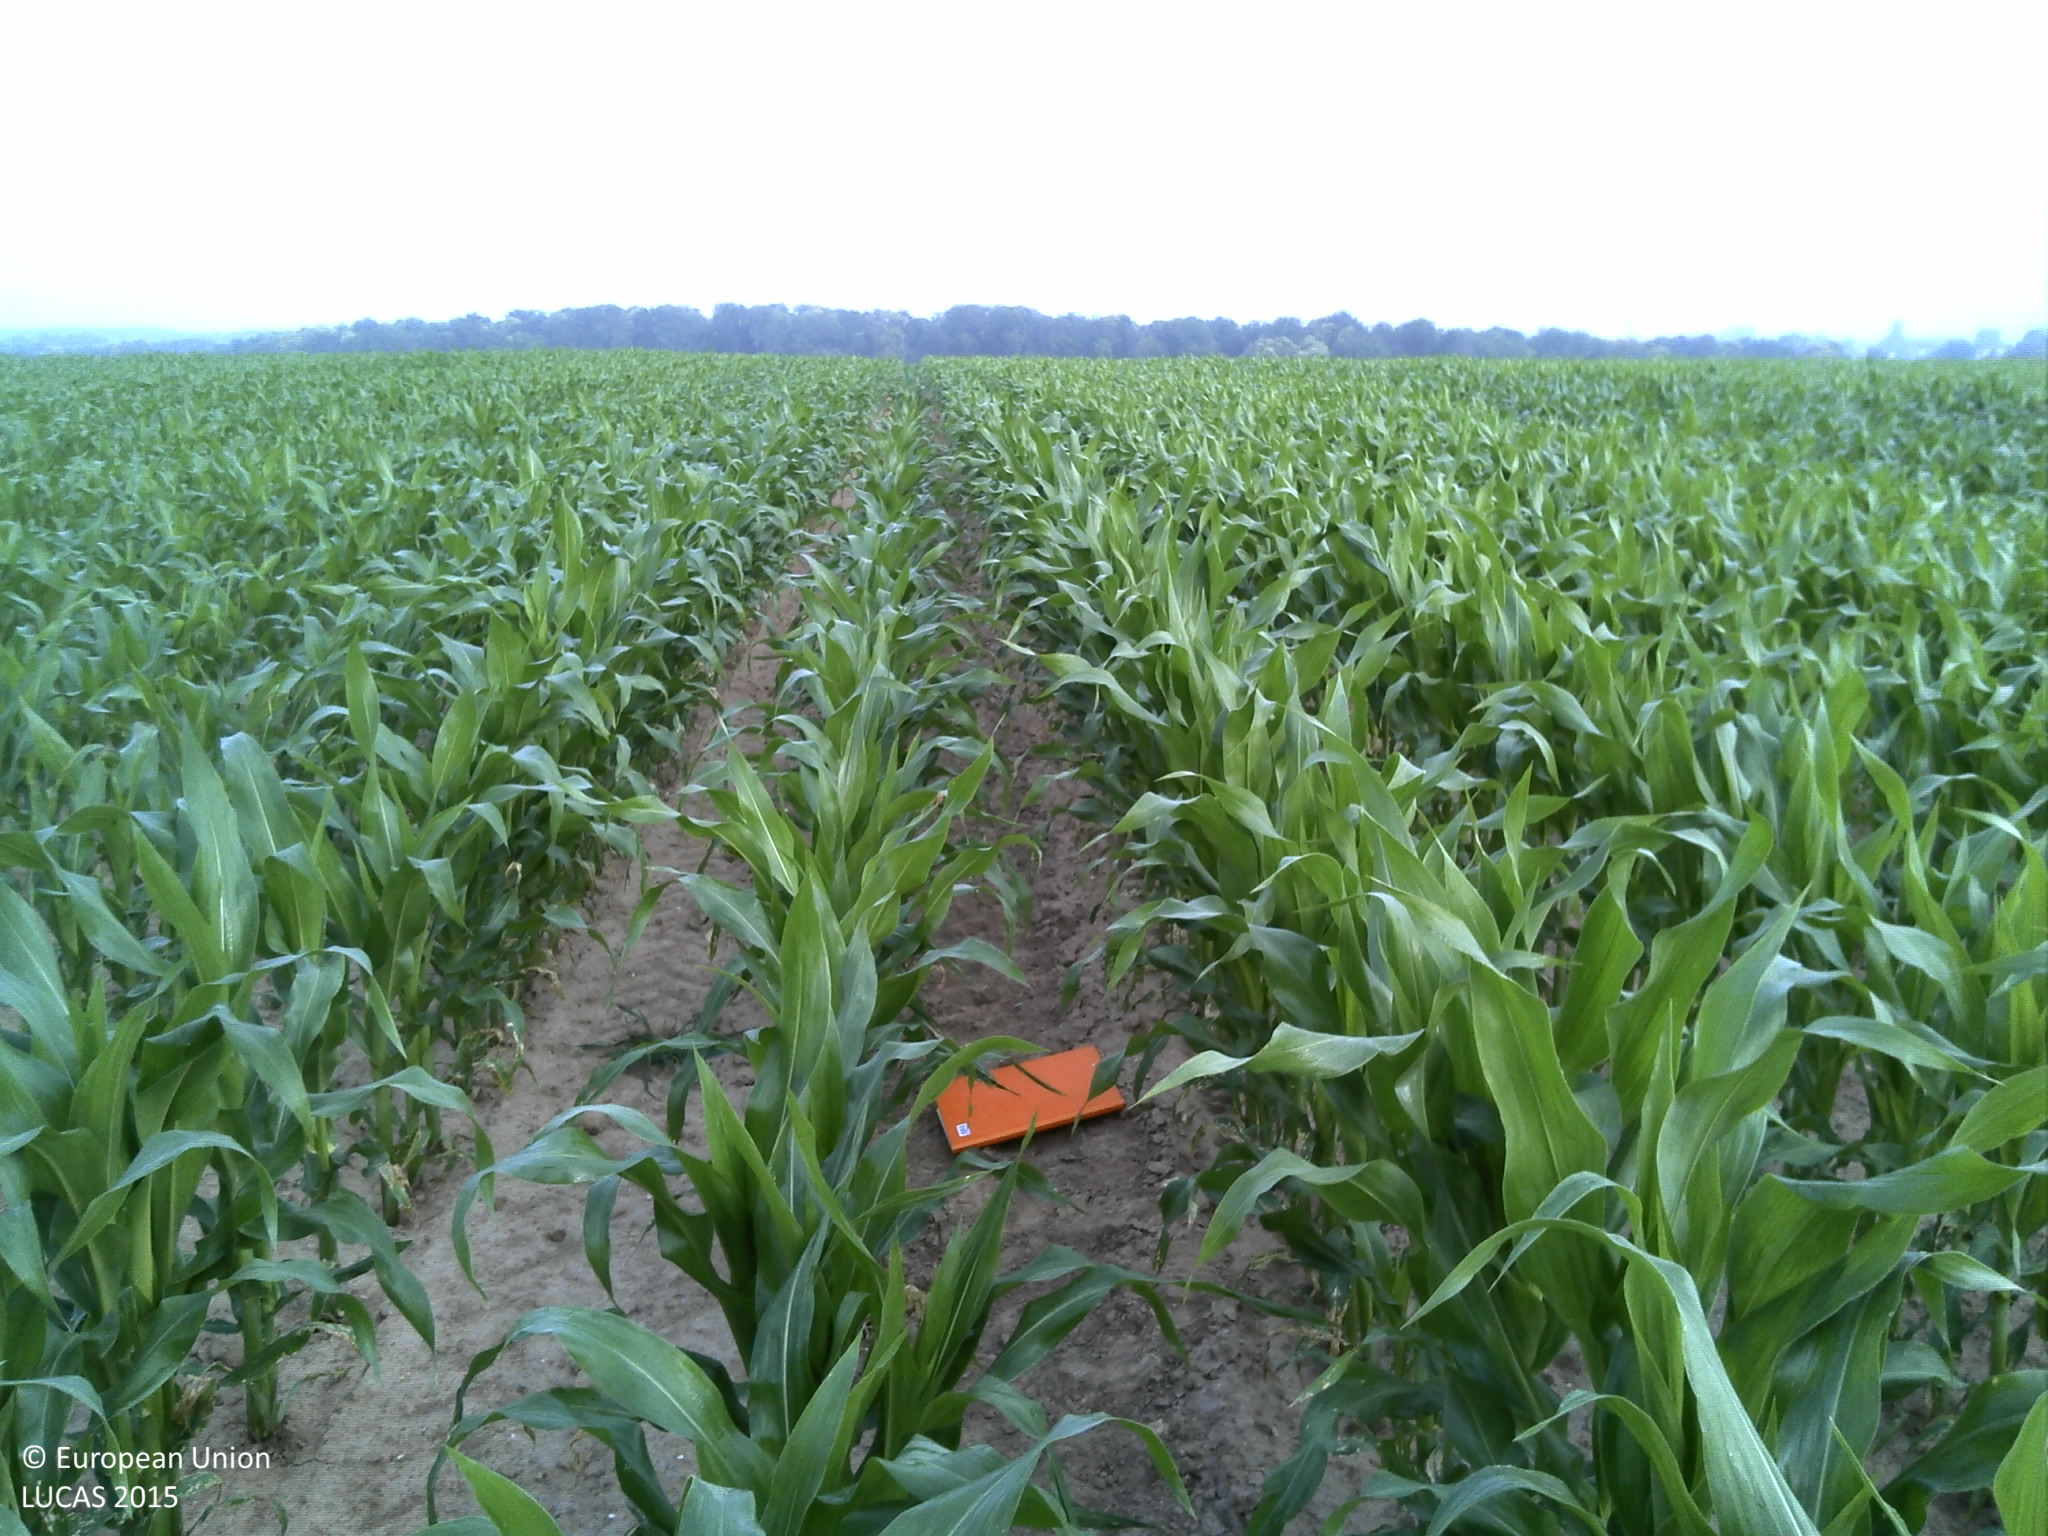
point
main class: Cropland
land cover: Maize
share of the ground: 50 - 75 %
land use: Agriculture (excluding fallow land and kitchen gardens)
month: July
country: FR
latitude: 49.3893
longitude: 1.1758
